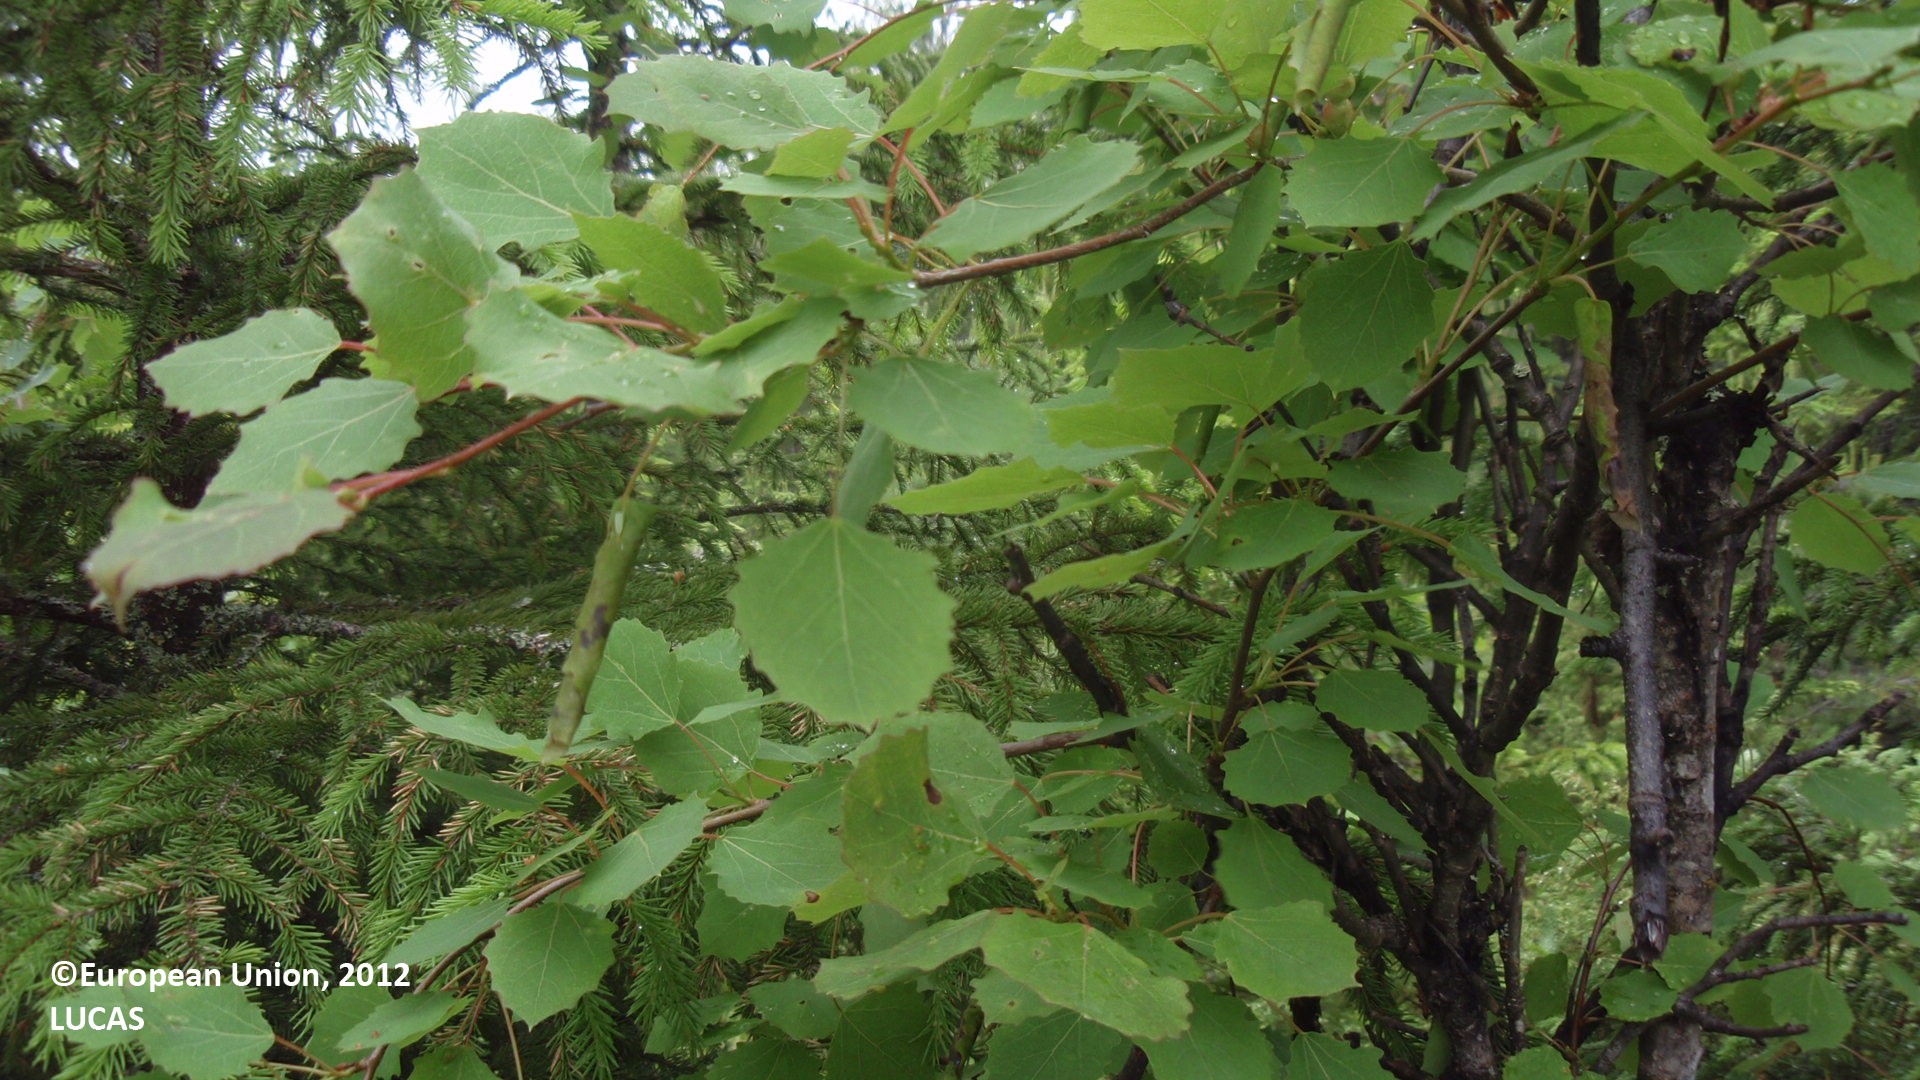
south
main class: Woodland
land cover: Spruce dominated coniferous woodland
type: boreal forest
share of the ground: > 75 %
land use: Forestry
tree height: < 5 m
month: June
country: FI
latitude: 61.3107
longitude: 26.7572
